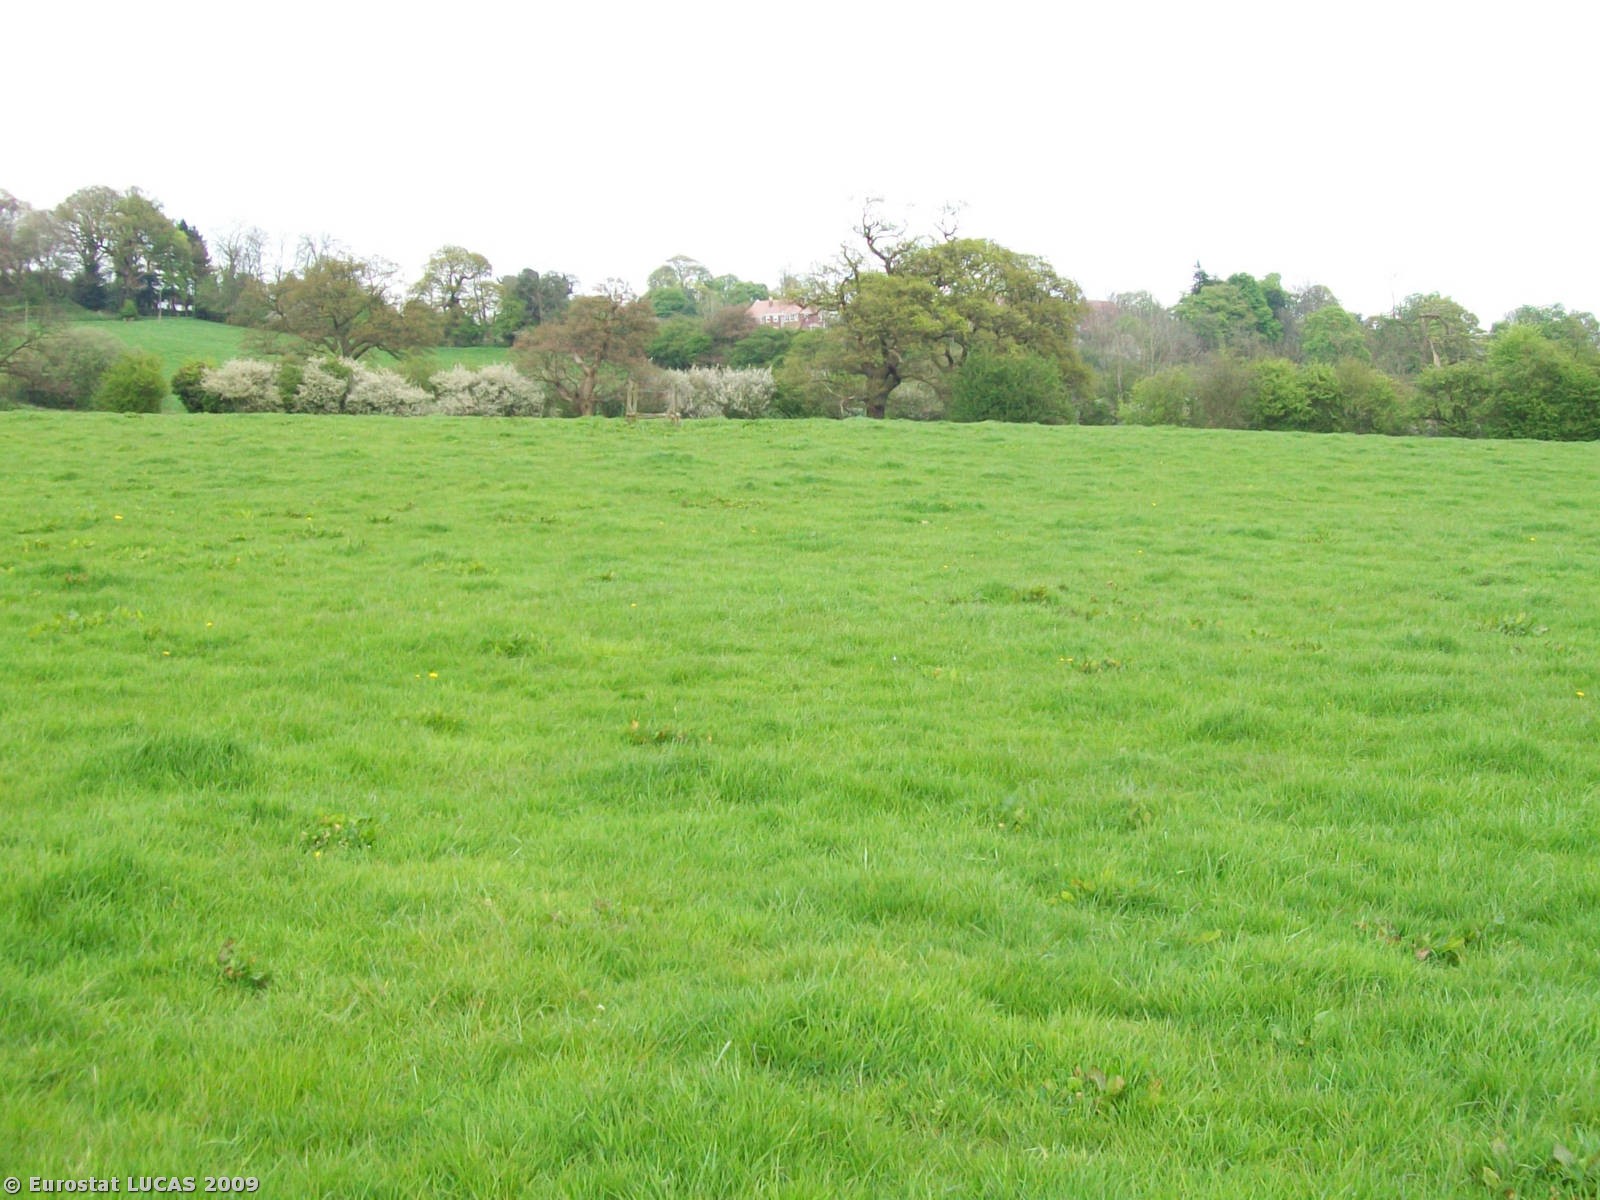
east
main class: Grassland
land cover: Grassland with sparse tree/shrub cover
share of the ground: > 75 %
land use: Agriculture (excluding fallow land and kitchen gardens)
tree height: > 5 m
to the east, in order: Grassland with sparse tree/shrub cover; Fences; Managed hedges; Grassland without tree/shrub cover; Fences; Managed hedges; Grassland without tree/shrub cover
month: April
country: GB
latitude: 52.9965
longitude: -1.5083
